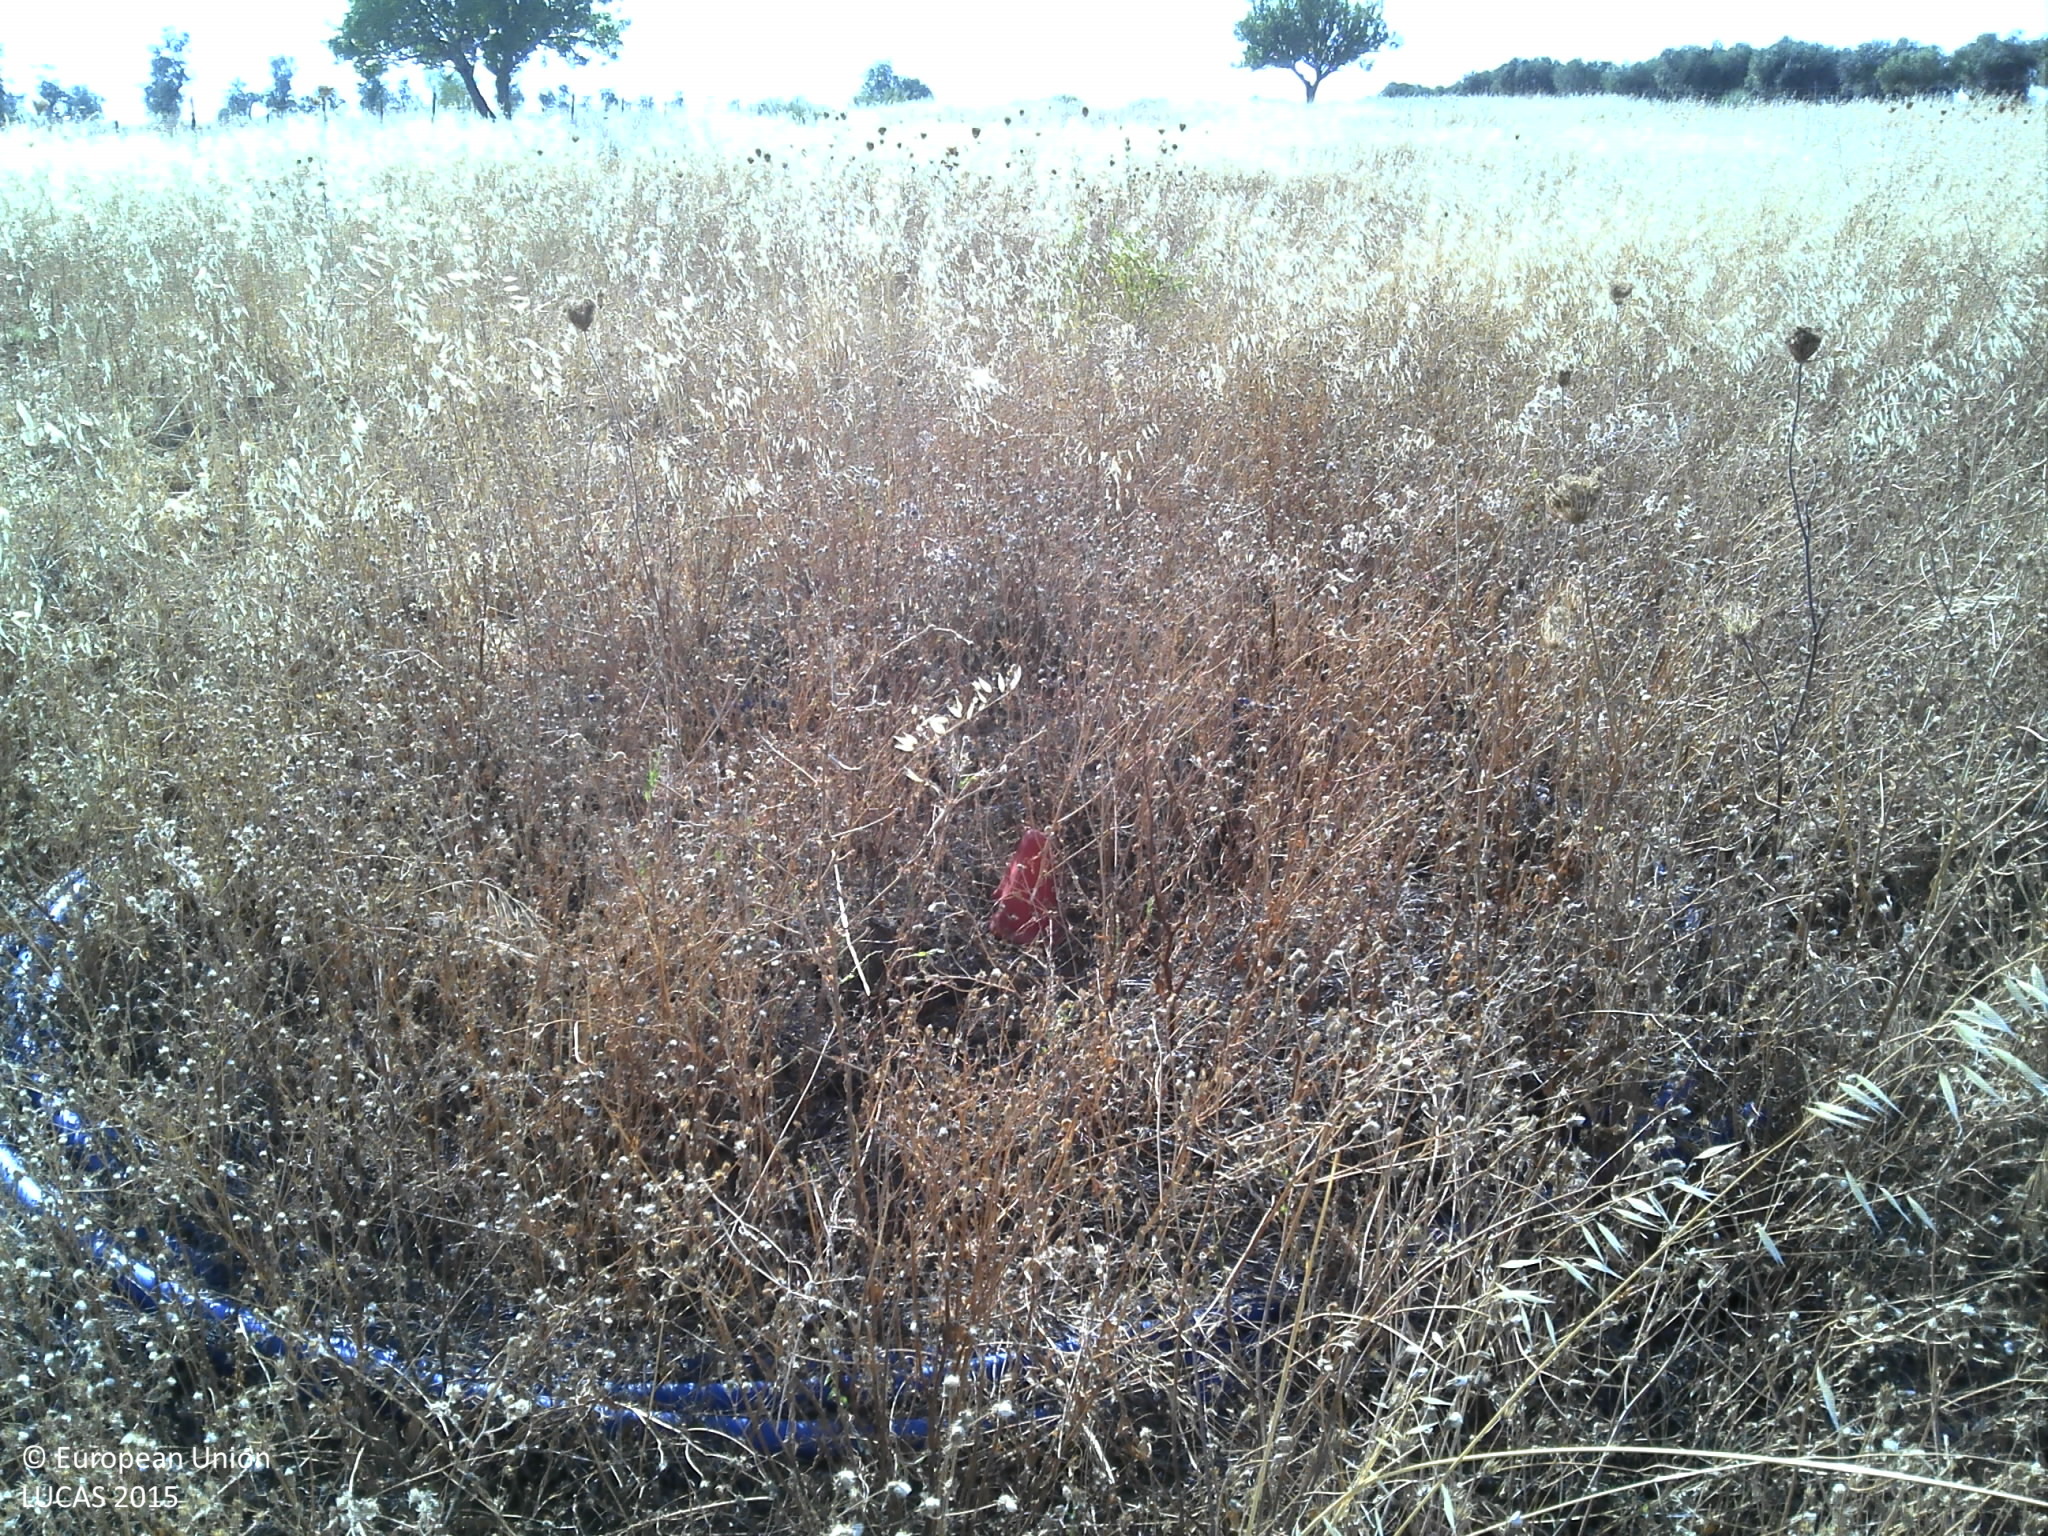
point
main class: Grassland
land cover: Grassland without tree/shrub cover
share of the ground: > 75 %
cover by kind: herbaceous plants 100 %
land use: Agriculture (excluding fallow land and kitchen gardens)
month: June
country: PT
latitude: 38.2810
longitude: -7.3634
